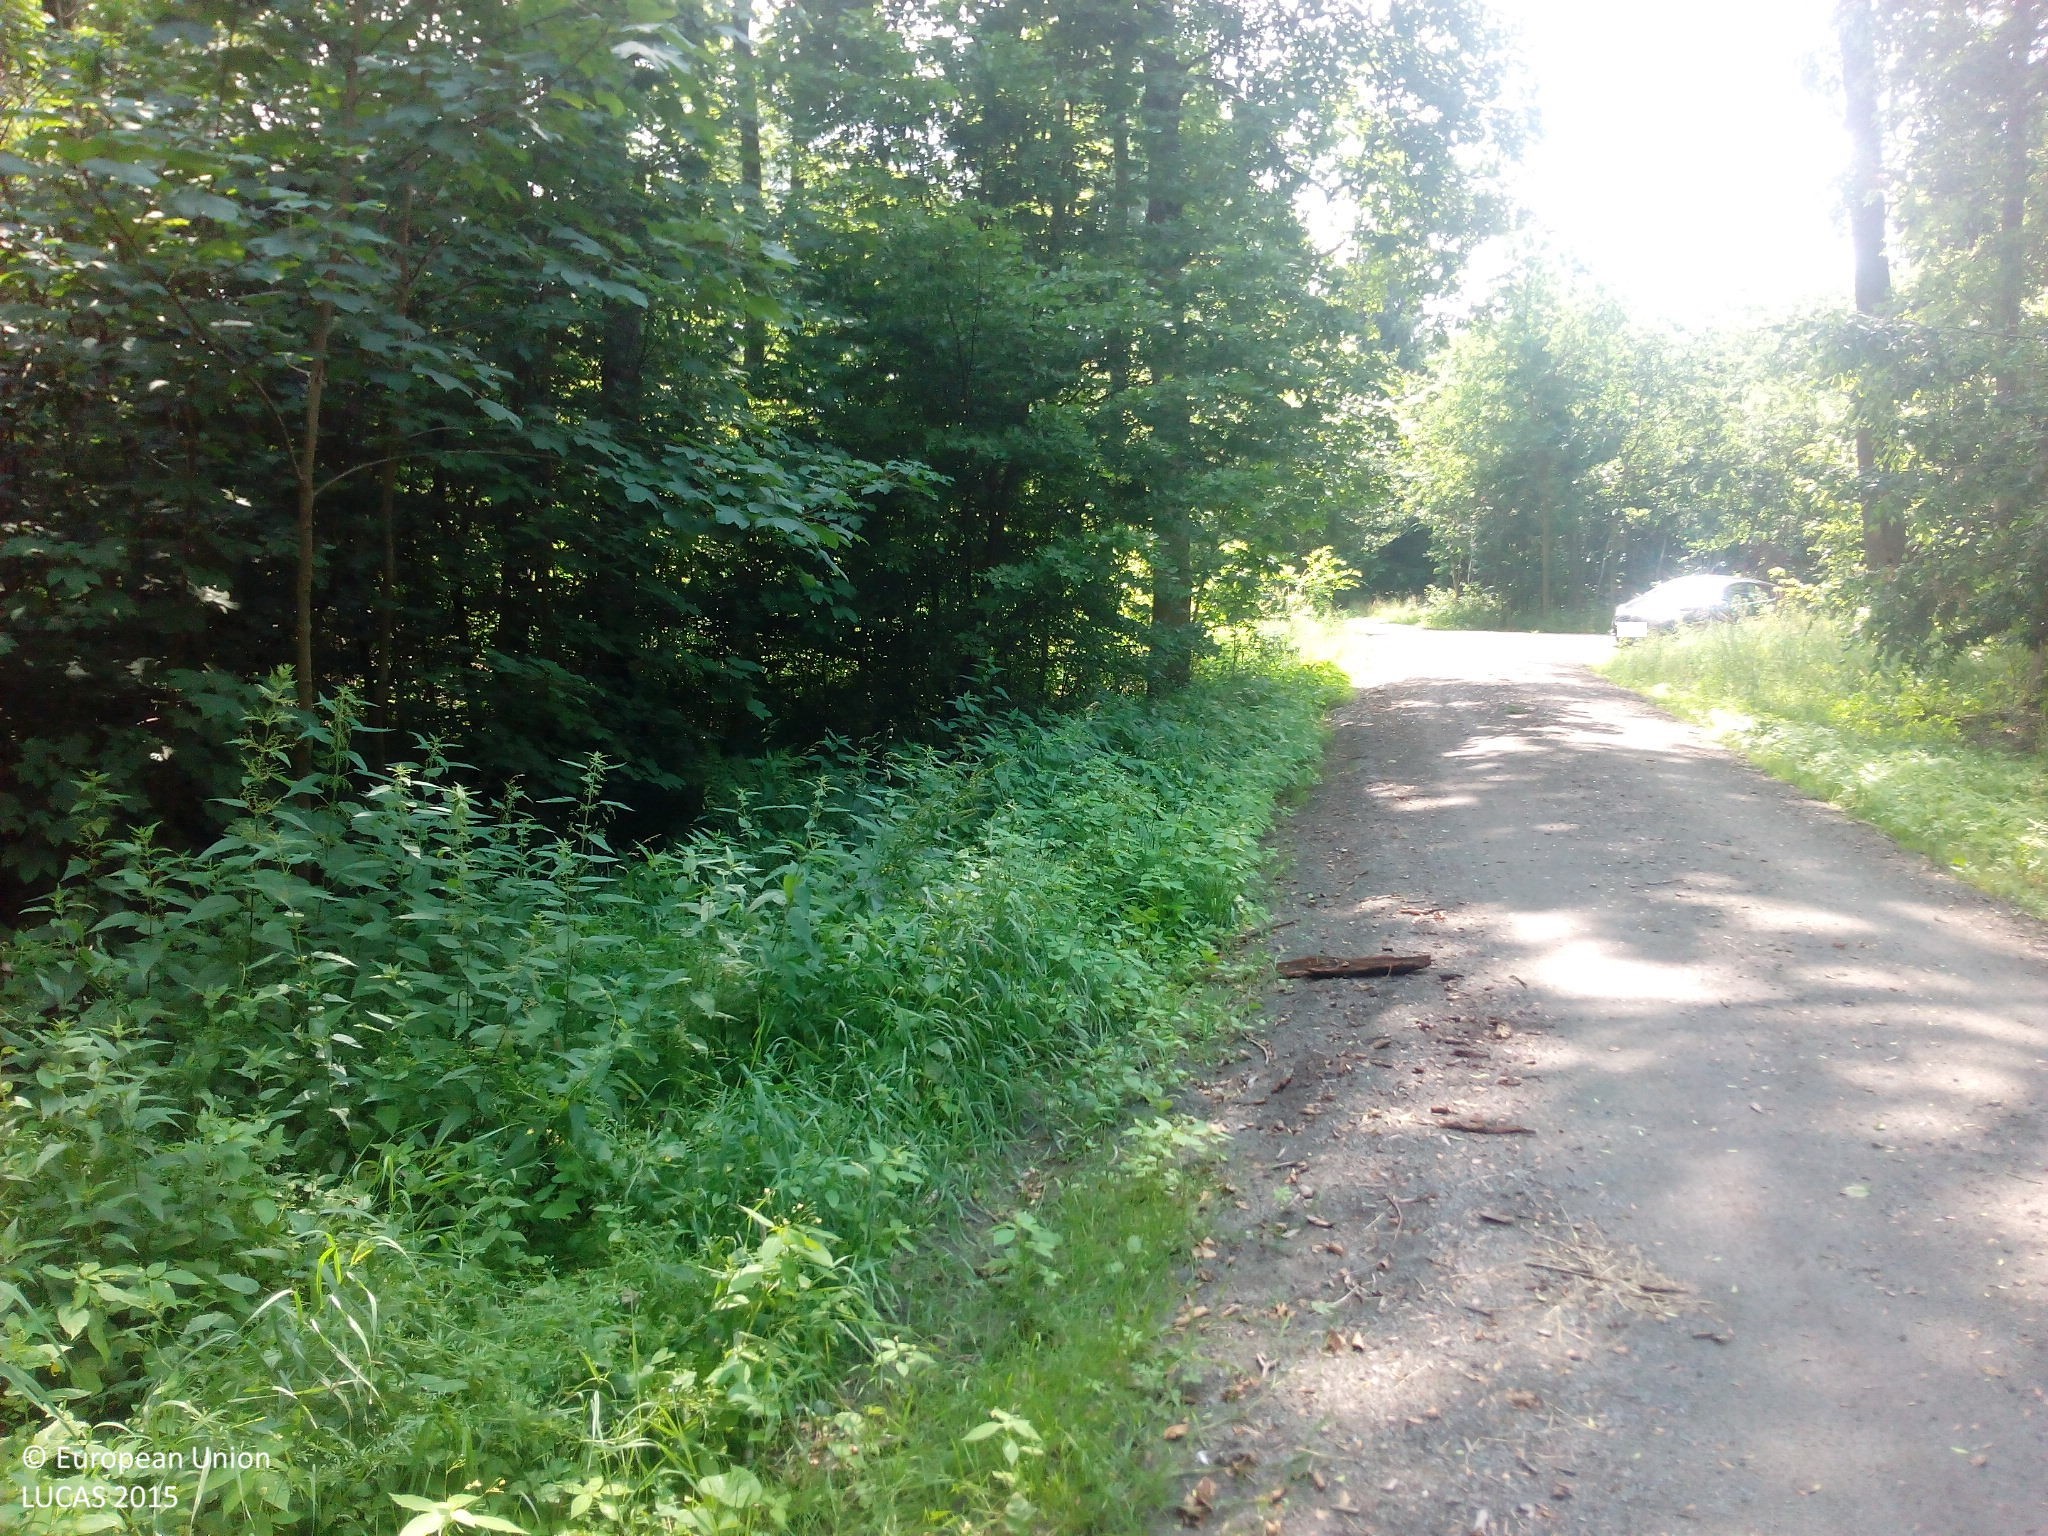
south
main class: Woodland
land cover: Broadleaved woodland
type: mesophytic deciduous forest
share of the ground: > 75 %
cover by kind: broadleaved forest trees 95 %, herbaceous plants 5 %
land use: Forestry
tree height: > 5 m
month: July
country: DE
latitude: 52.8384
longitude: 12.4192
